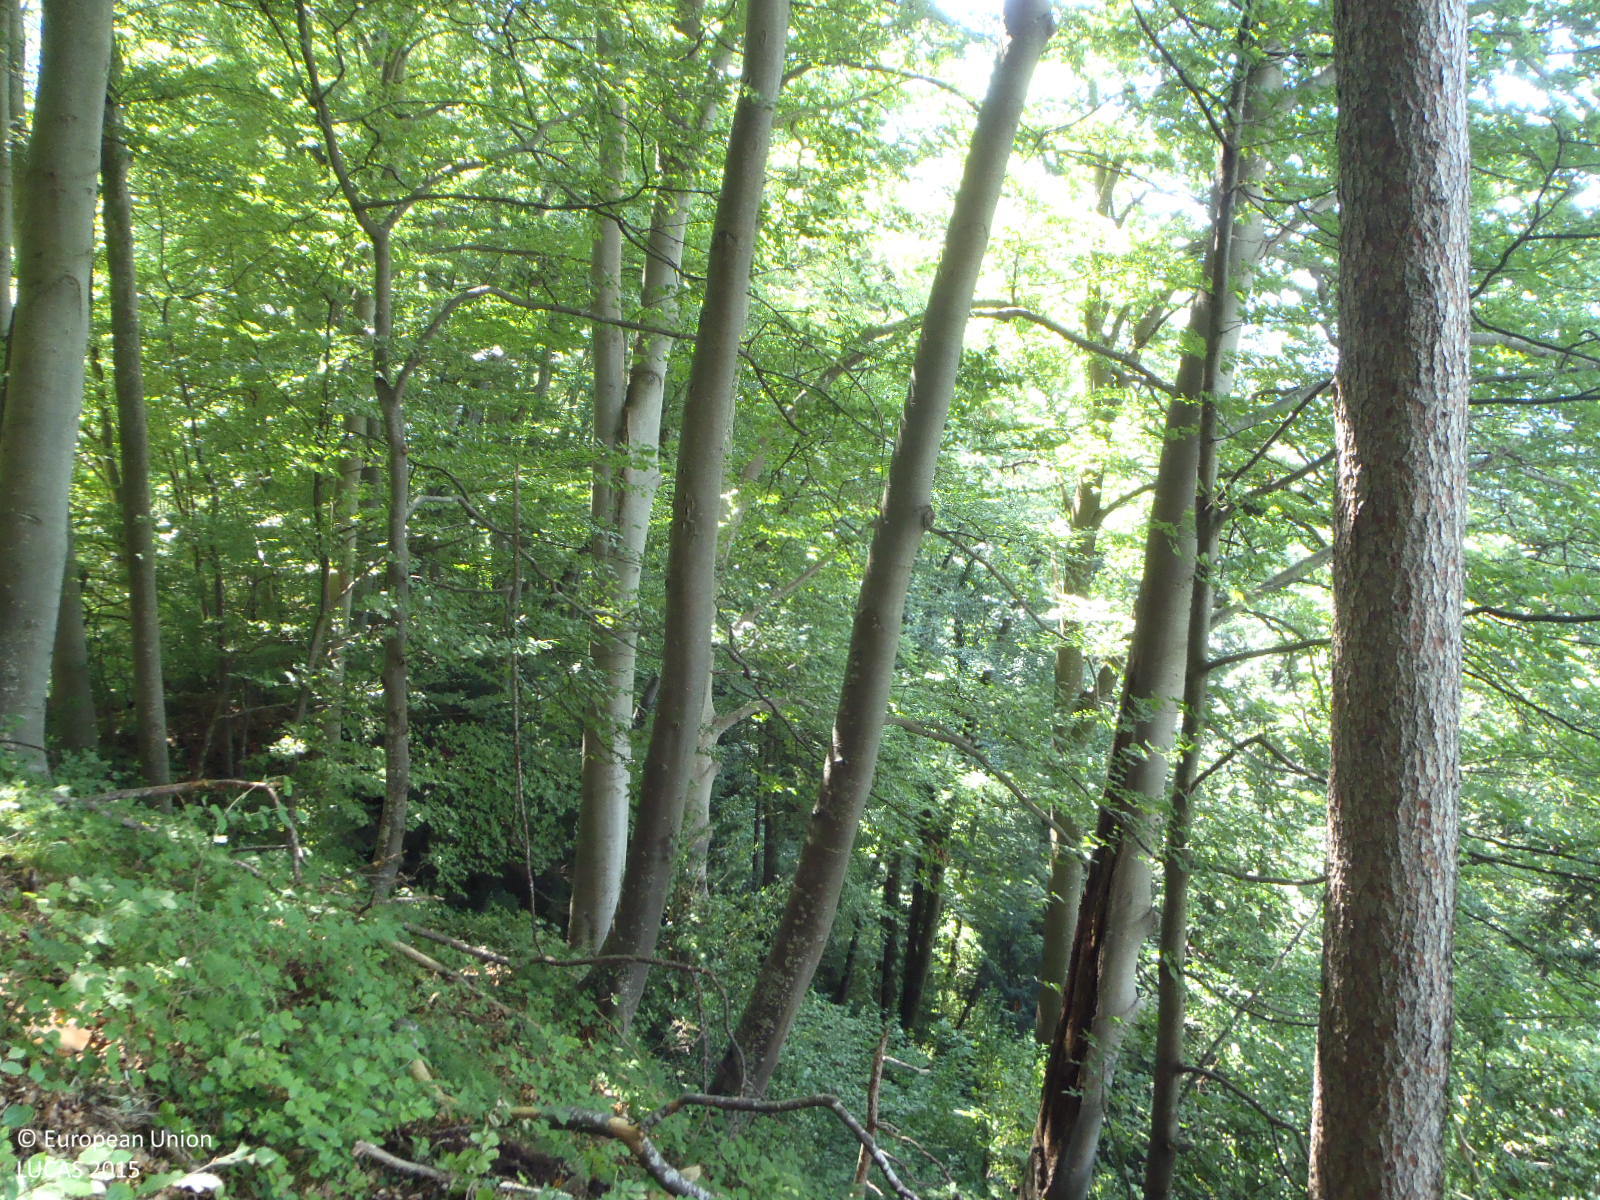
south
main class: Woodland
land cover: Broadleaved woodland
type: mountainous beech forest
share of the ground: > 75 %
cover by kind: broadleaved forest trees 80 %, coniferous forest trees 10 %, herbaceous plants 10 %
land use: Forestry
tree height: > 5 m
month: July
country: AT
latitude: 47.3411
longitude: 9.6694
